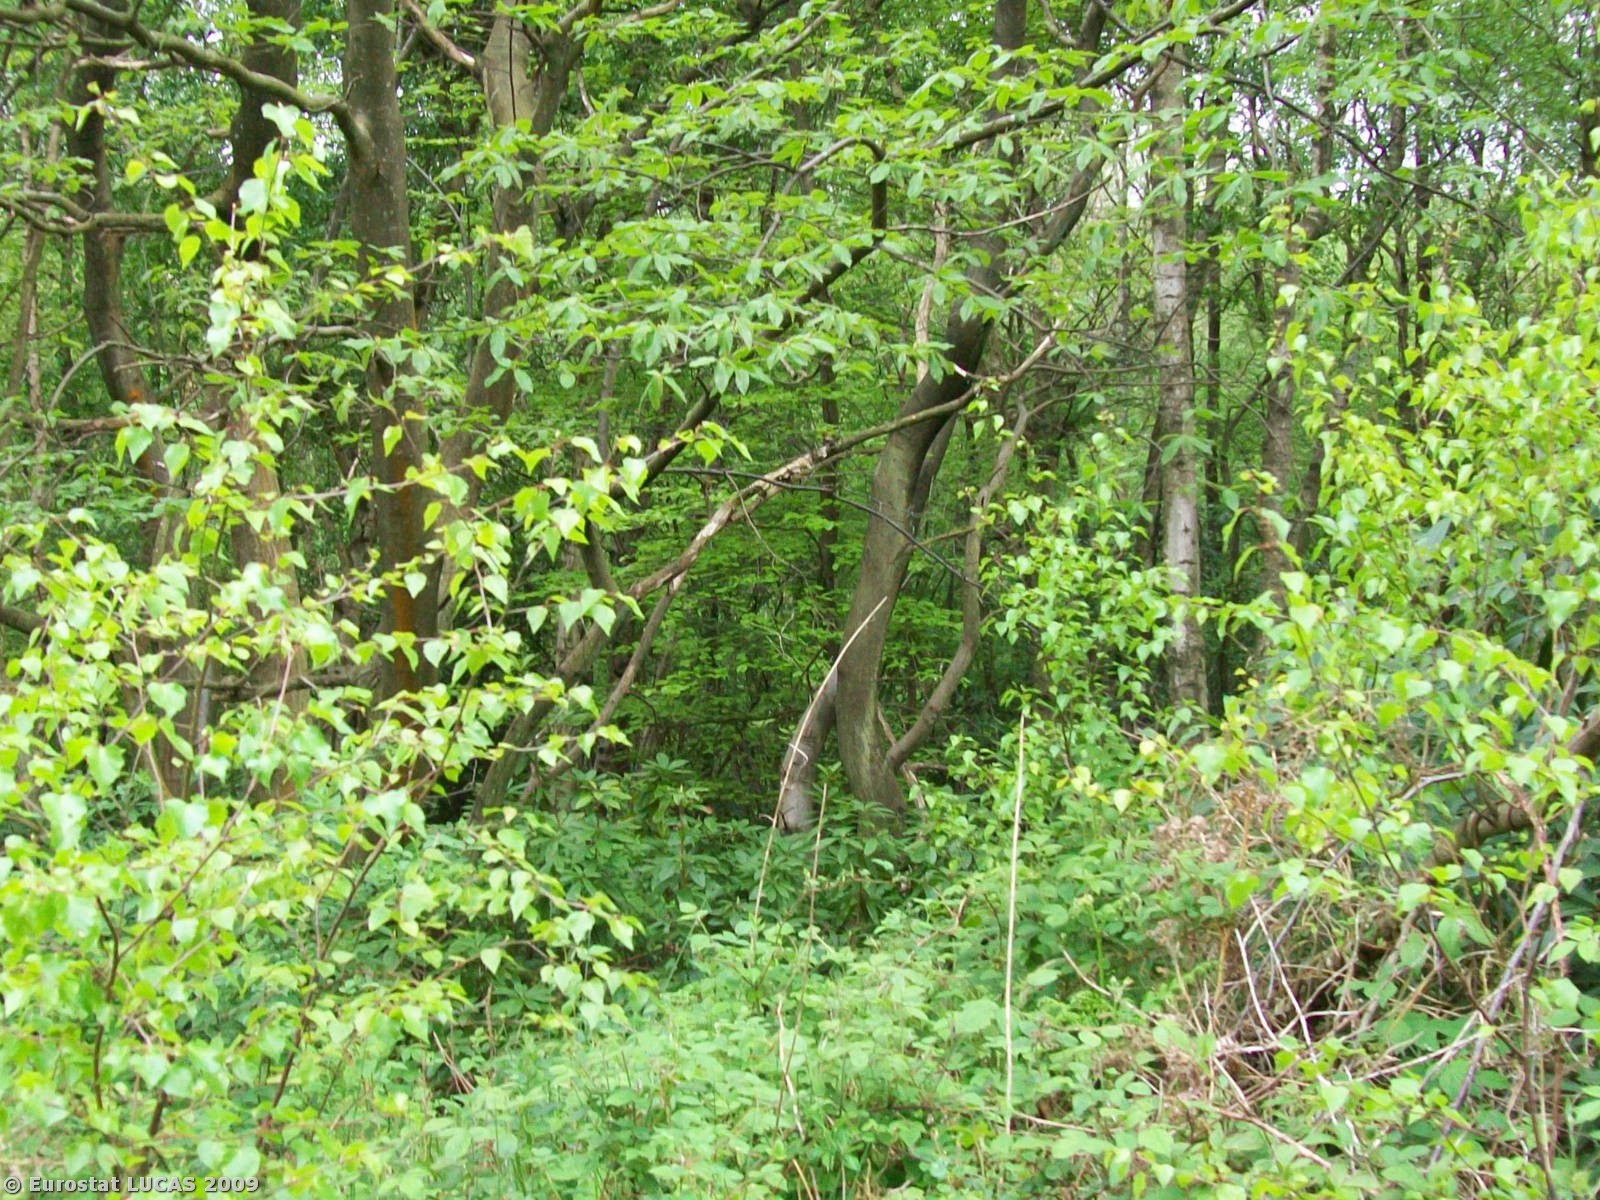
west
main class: Woodland
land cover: Mixed woodland
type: mesophytic deciduous forest
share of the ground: > 75 %
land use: Forestry
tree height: > 5 m
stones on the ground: < 10 %
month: May
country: GB
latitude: 51.1125
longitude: 0.3286
